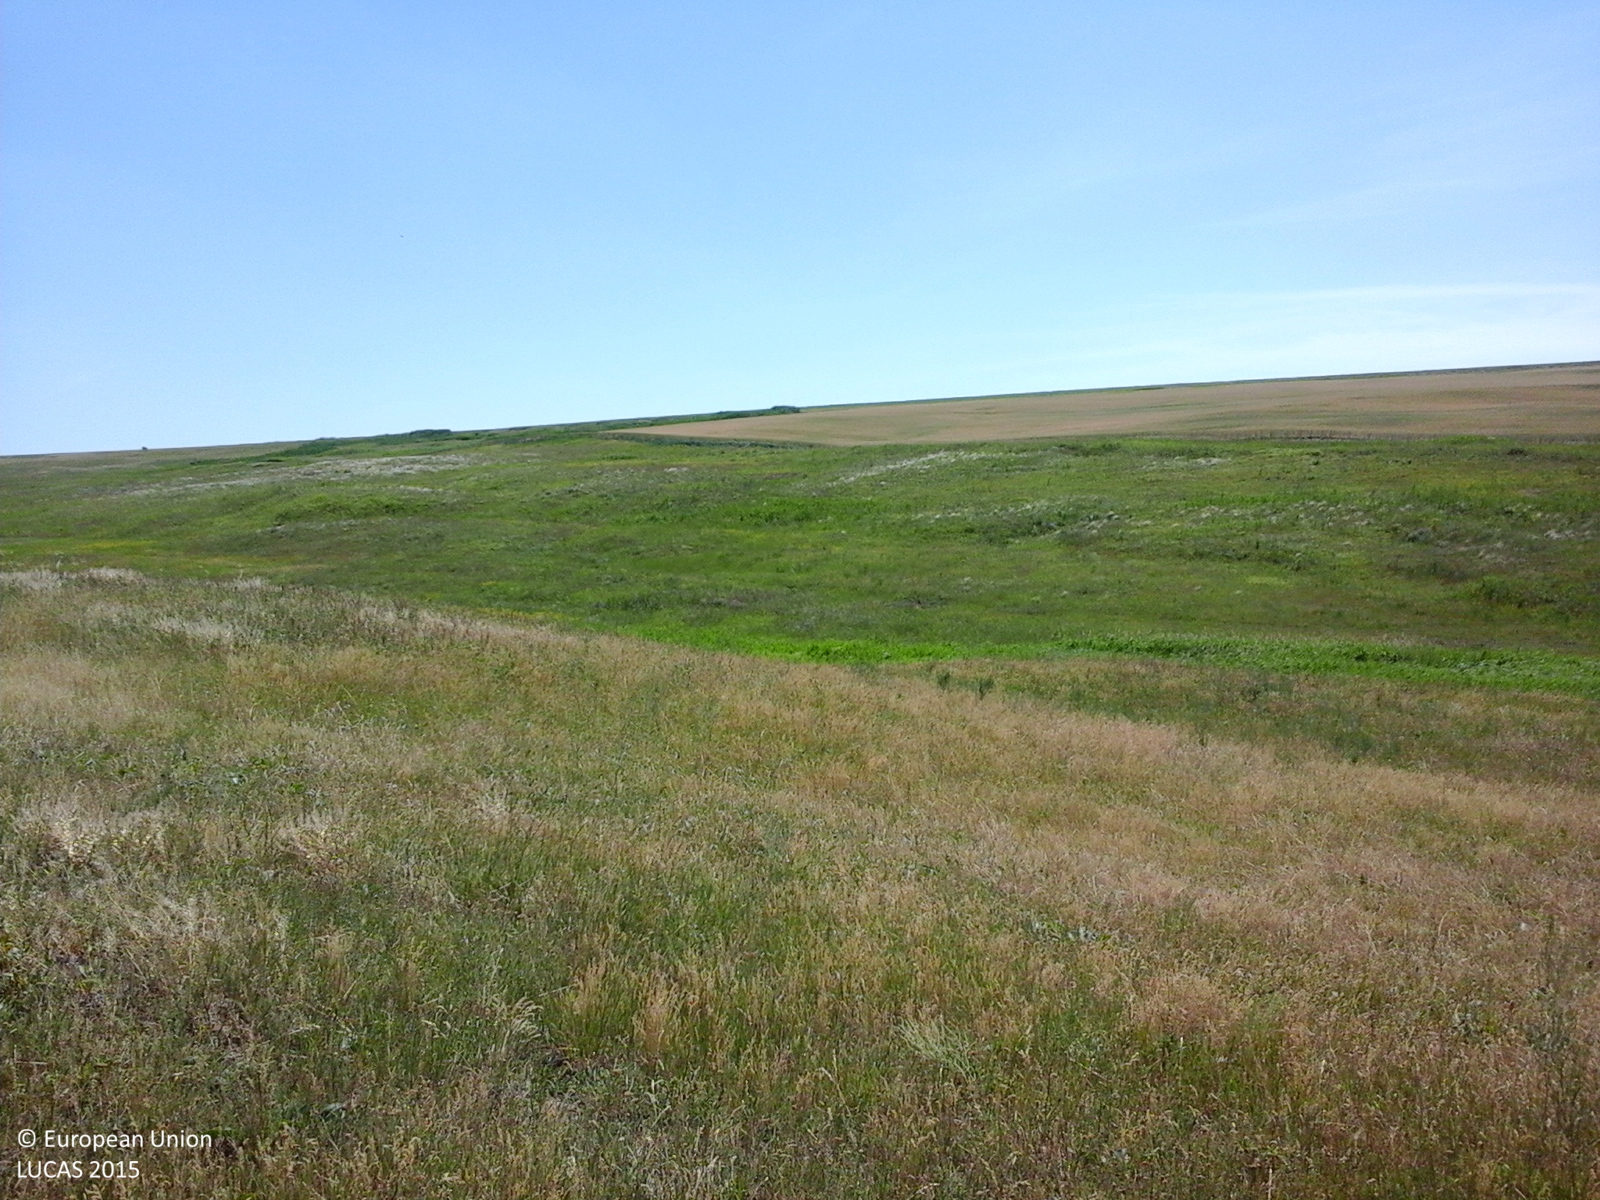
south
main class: Grassland
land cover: Grassland without tree/shrub cover
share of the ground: > 75 %
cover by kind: herbaceous plants 100 %
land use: Agriculture (excluding fallow land and kitchen gardens)
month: June
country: RO
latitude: 47.4833
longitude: 26.9696
